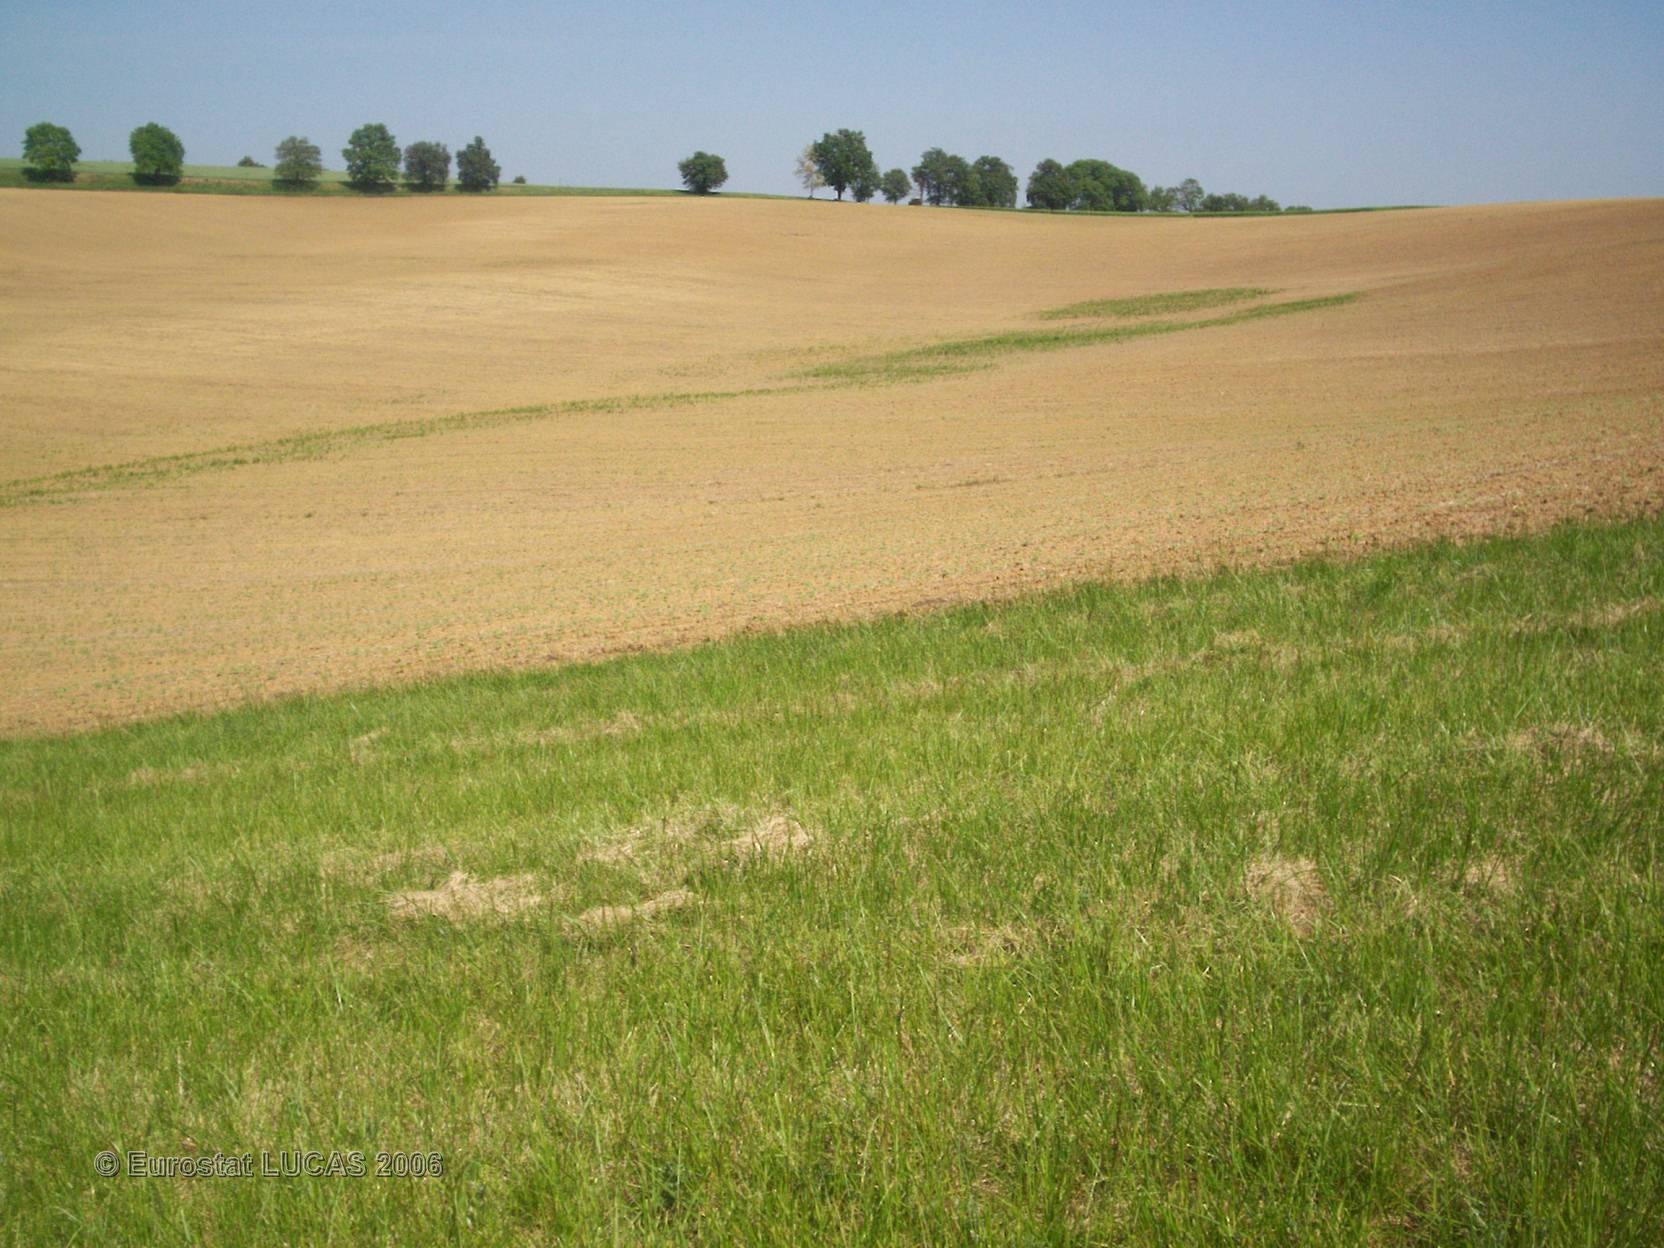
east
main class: Grassland
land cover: Grassland without tree/shrub cover
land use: Agriculture (excluding fallow land and kitchen gardens)
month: May
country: FR
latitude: 43.4415
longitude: 0.8947
